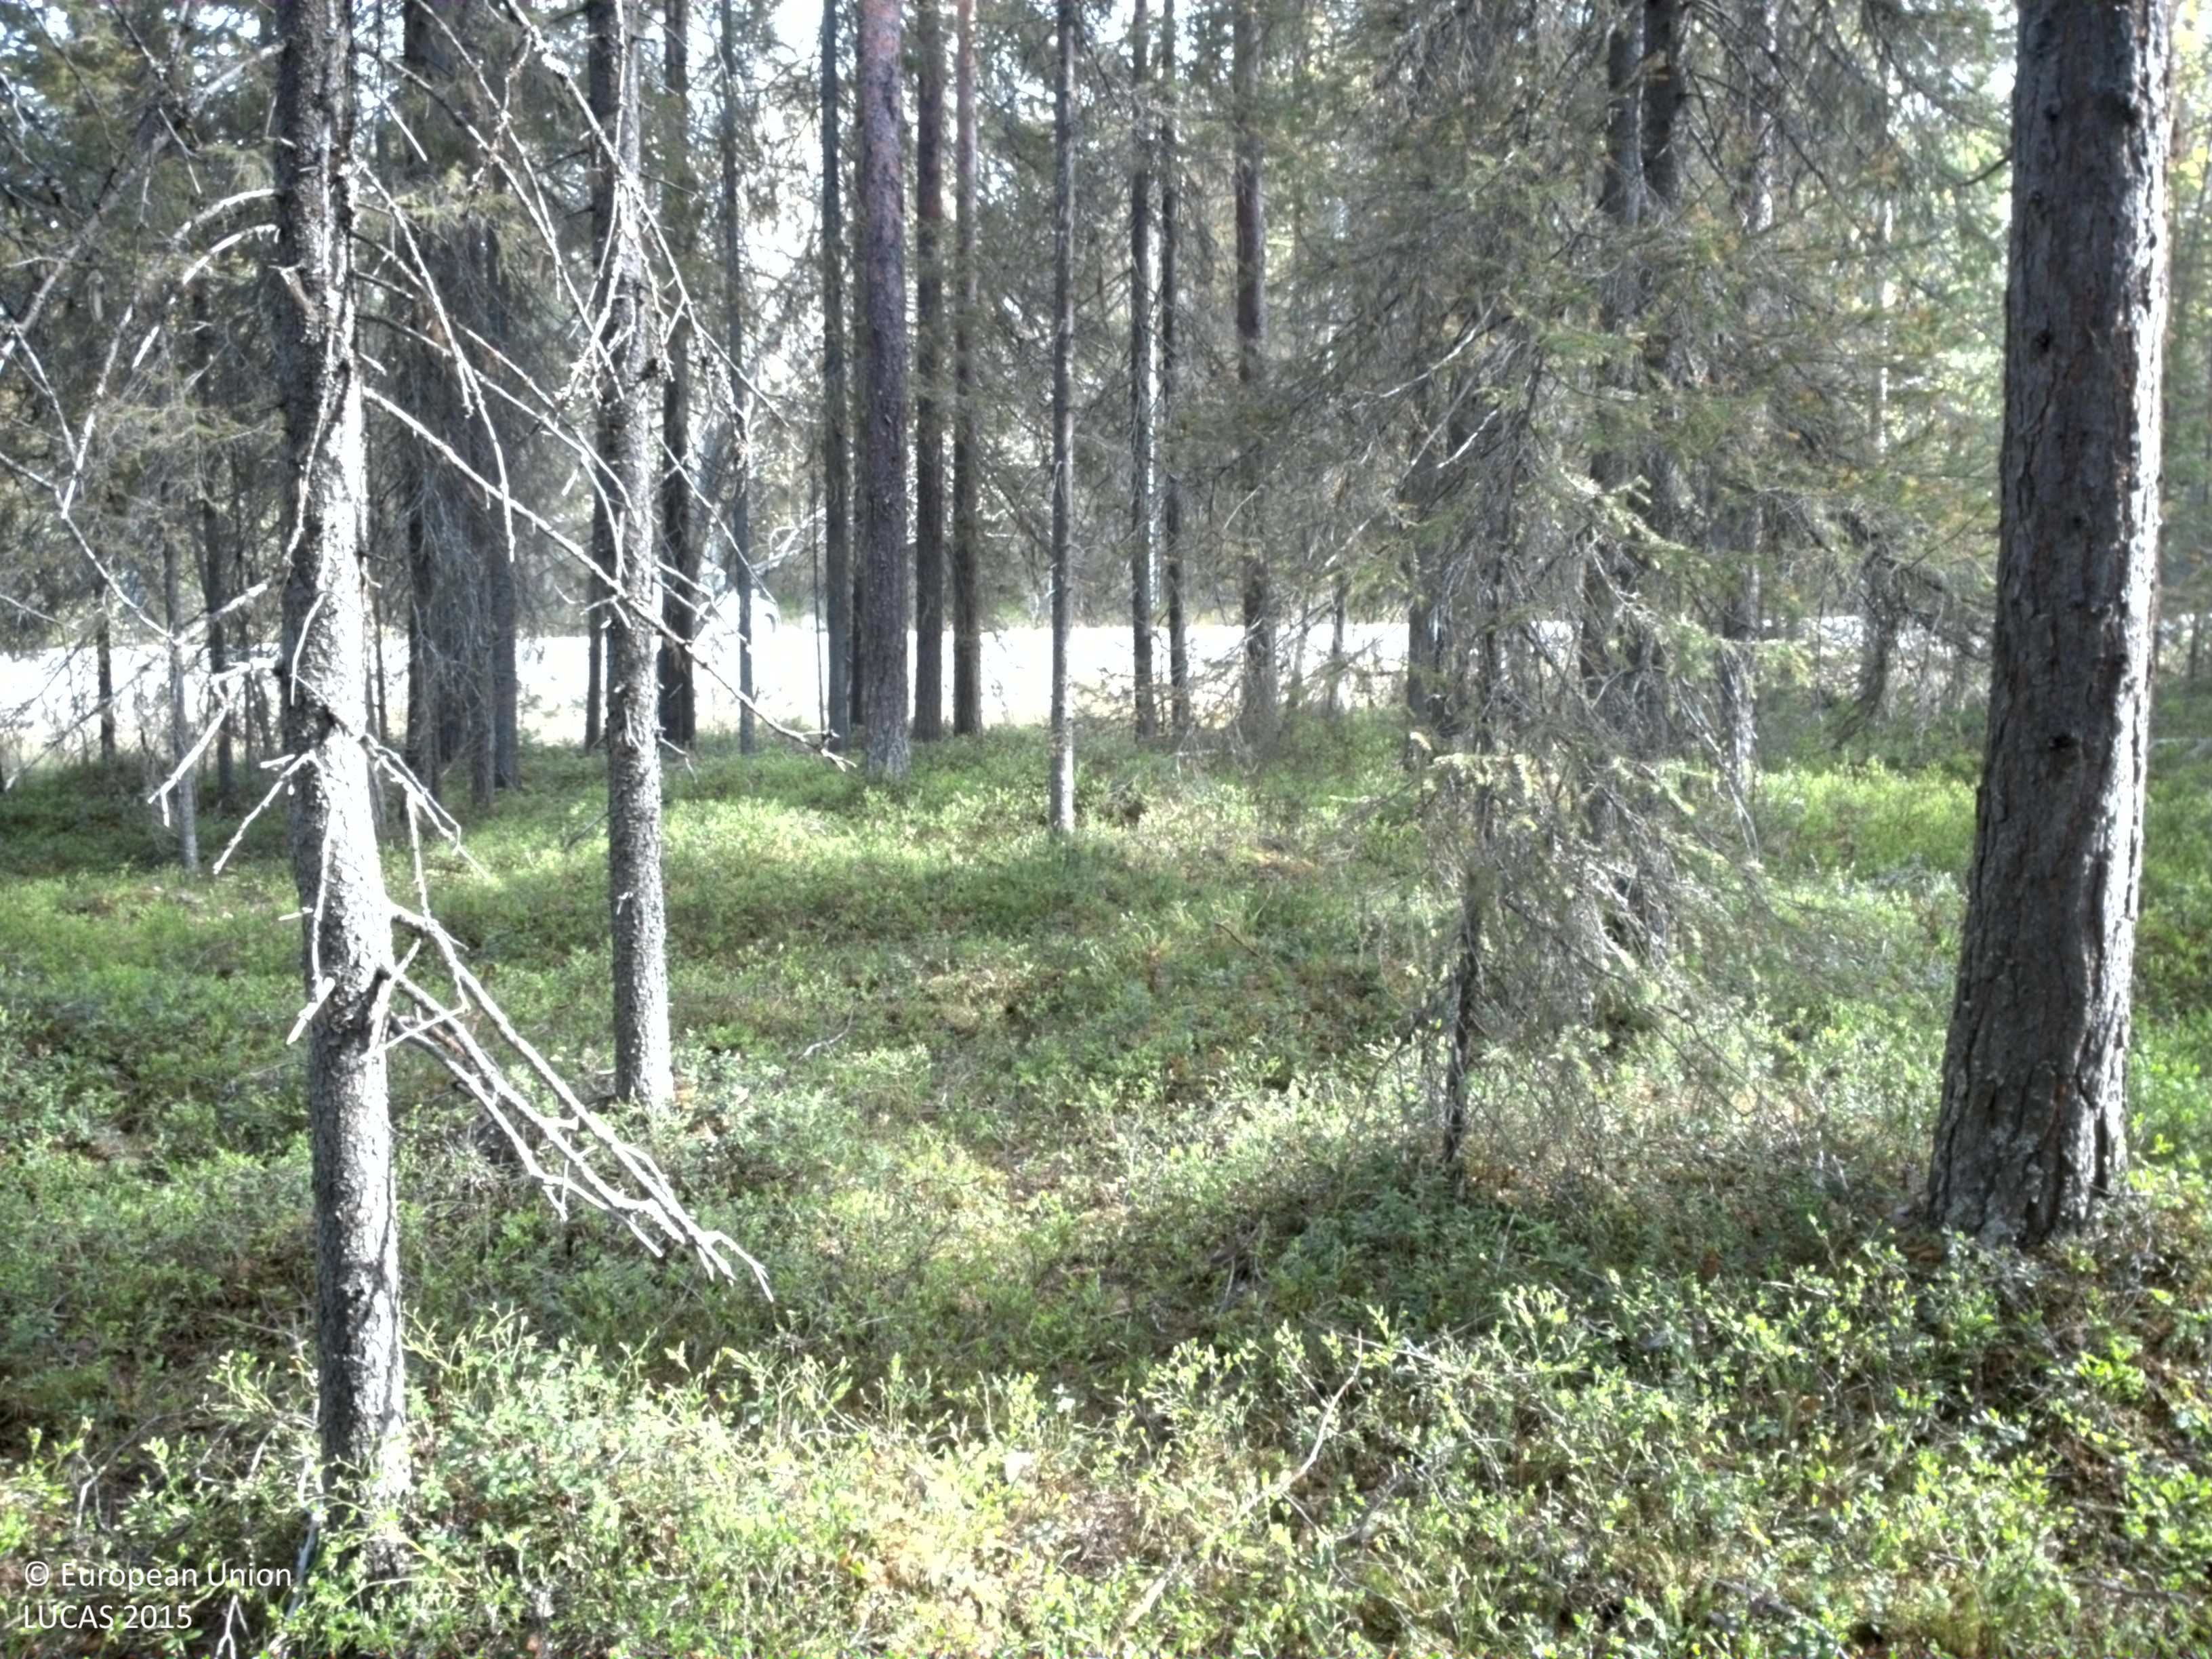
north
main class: Woodland
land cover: Other coniferous woodland
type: boreal forest
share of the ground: 50 - 75 %
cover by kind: coniferous forest trees 65 %, shrubs 35 %
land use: Amenities, museums, leisure
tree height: > 5 m
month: June
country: SE
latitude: 65.7588
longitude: 19.7175
